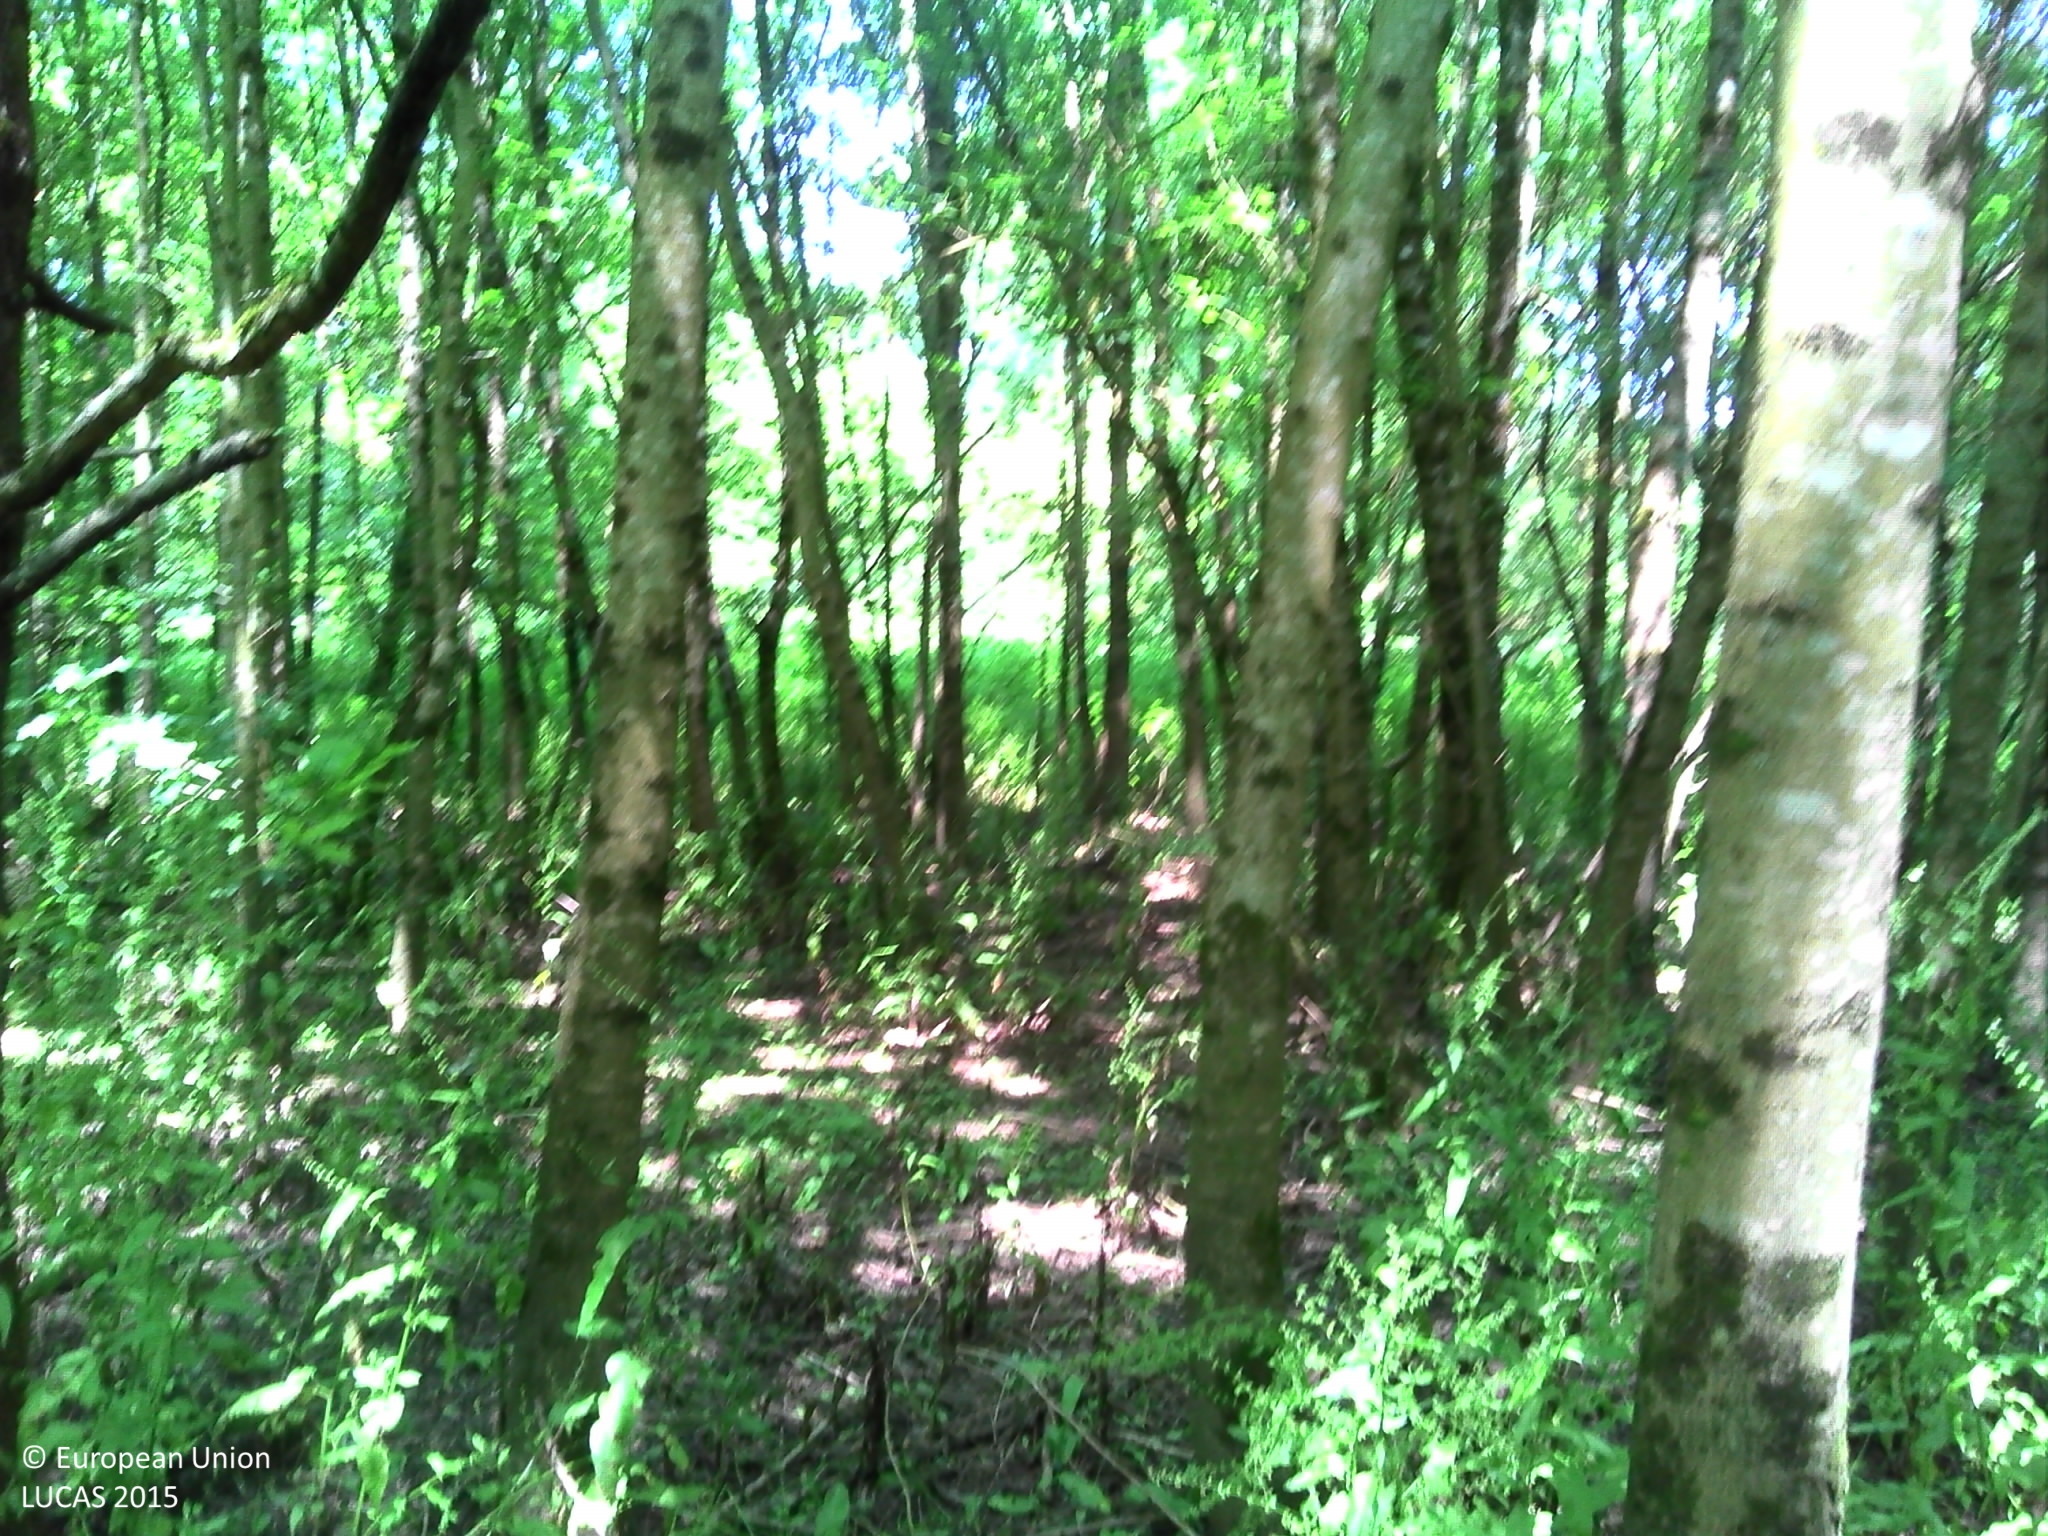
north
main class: Woodland
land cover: Broadleaved woodland
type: floodplain forest
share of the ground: > 75 %
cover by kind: broadleaved forest trees 95 %, herbaceous plants 5 %
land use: Semi-natural and natural areas not in use
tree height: > 5 m
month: June
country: FR
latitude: 47.1374
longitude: -1.4186
